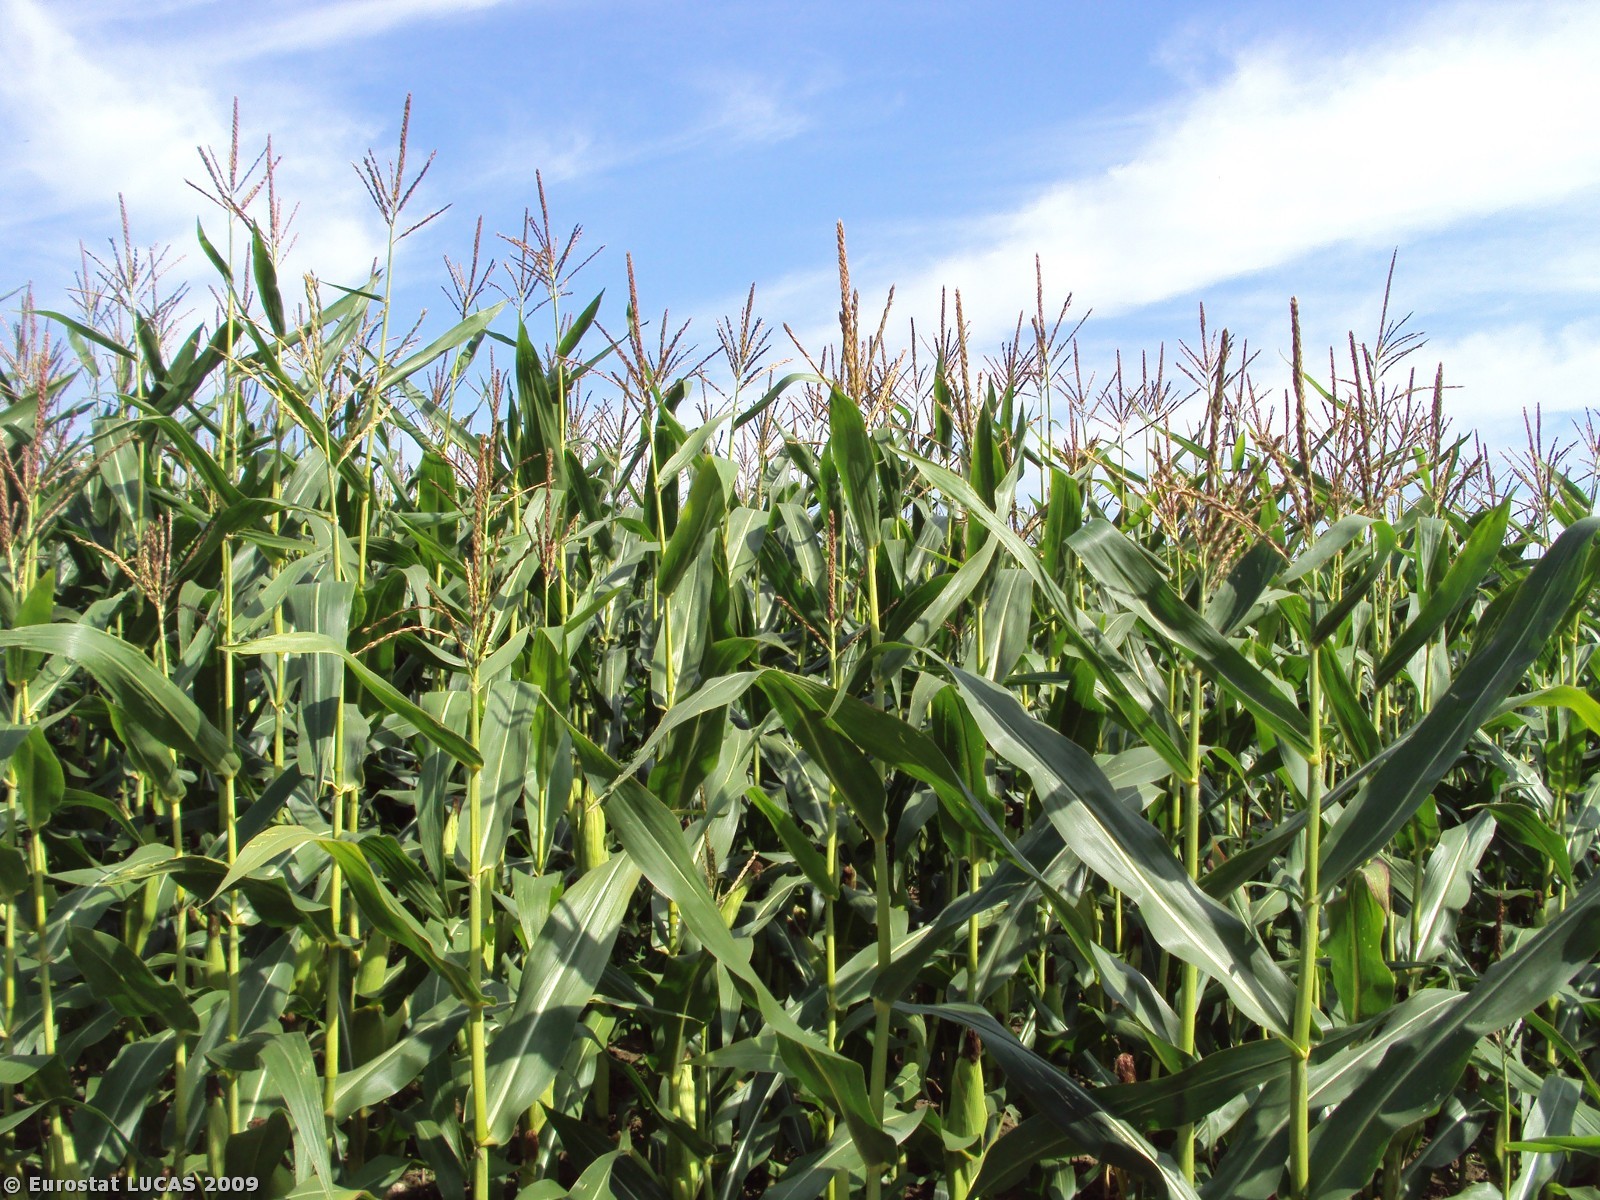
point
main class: Cropland
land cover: Maize
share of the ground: > 75 %
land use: Agriculture (excluding fallow land and kitchen gardens)
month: September
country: PL
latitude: 53.7253
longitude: 15.9305
